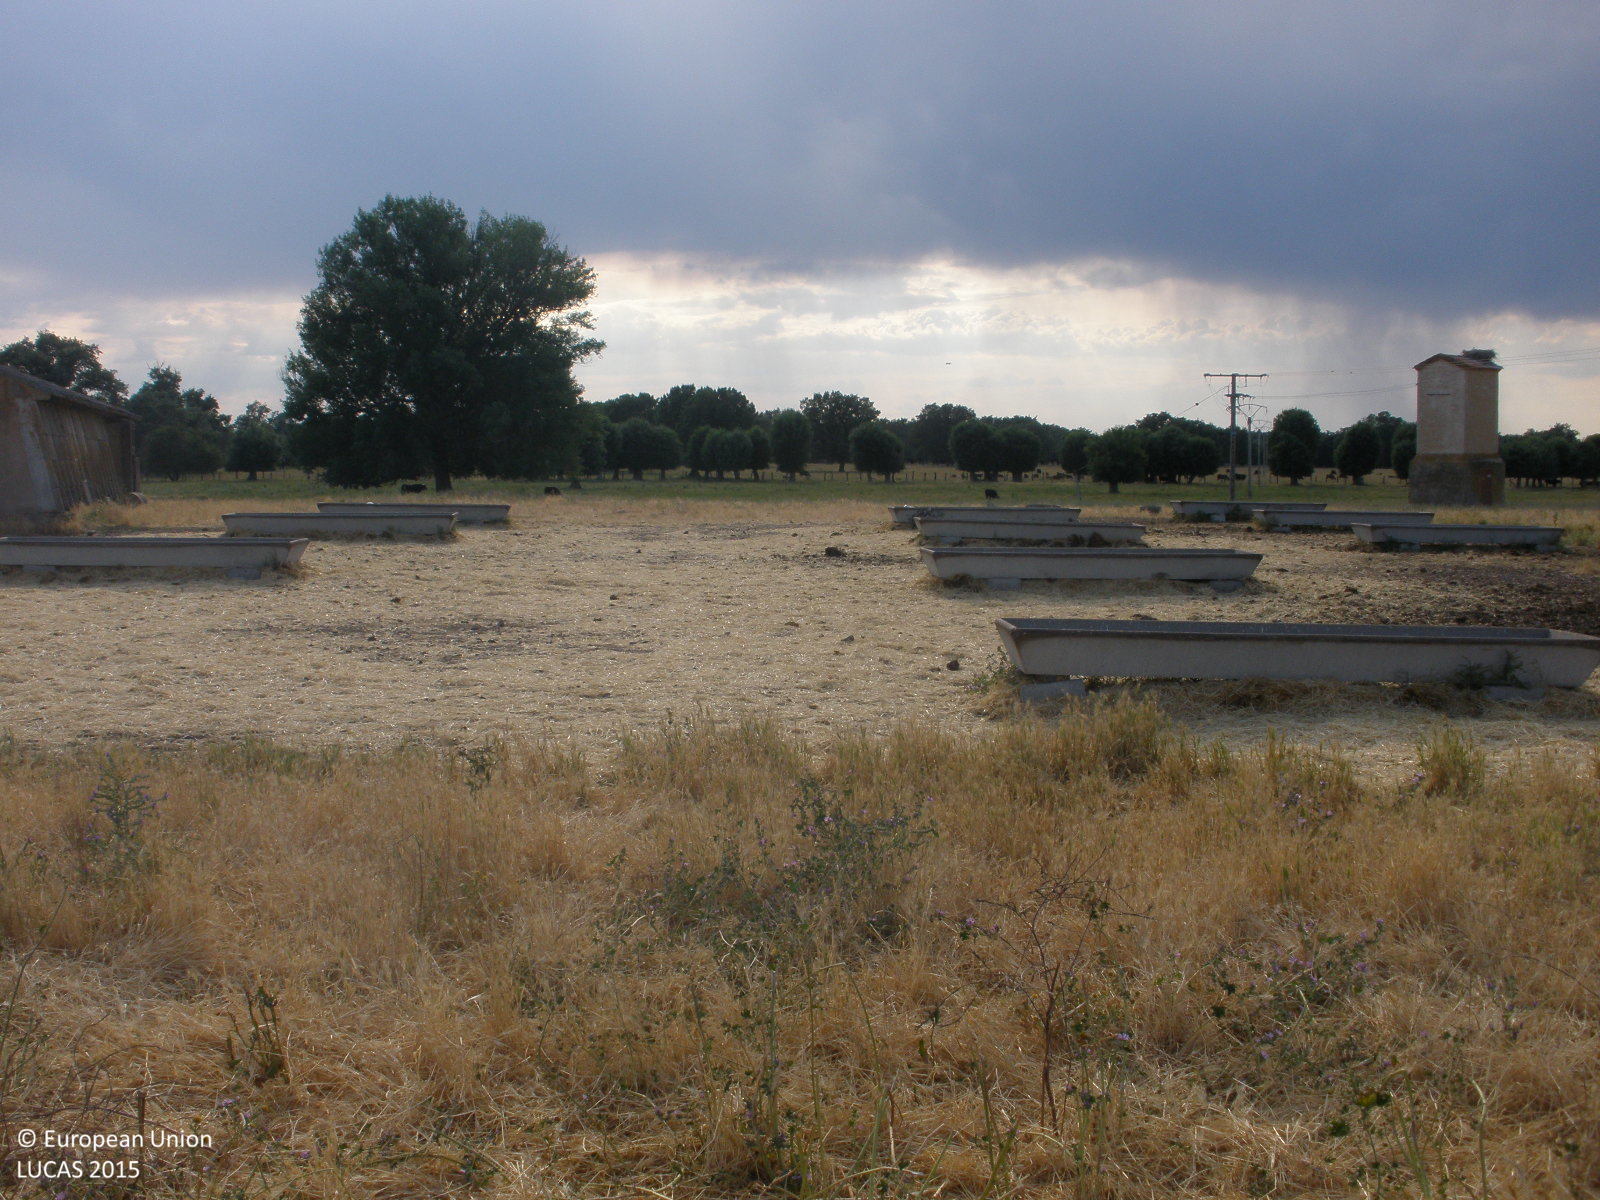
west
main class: Grassland
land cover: Grassland without tree/shrub cover
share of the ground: > 75 %
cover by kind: herbaceous plants 100 %
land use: Agriculture (excluding fallow land and kitchen gardens)
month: June
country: ES
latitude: 40.7312
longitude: -6.3206
